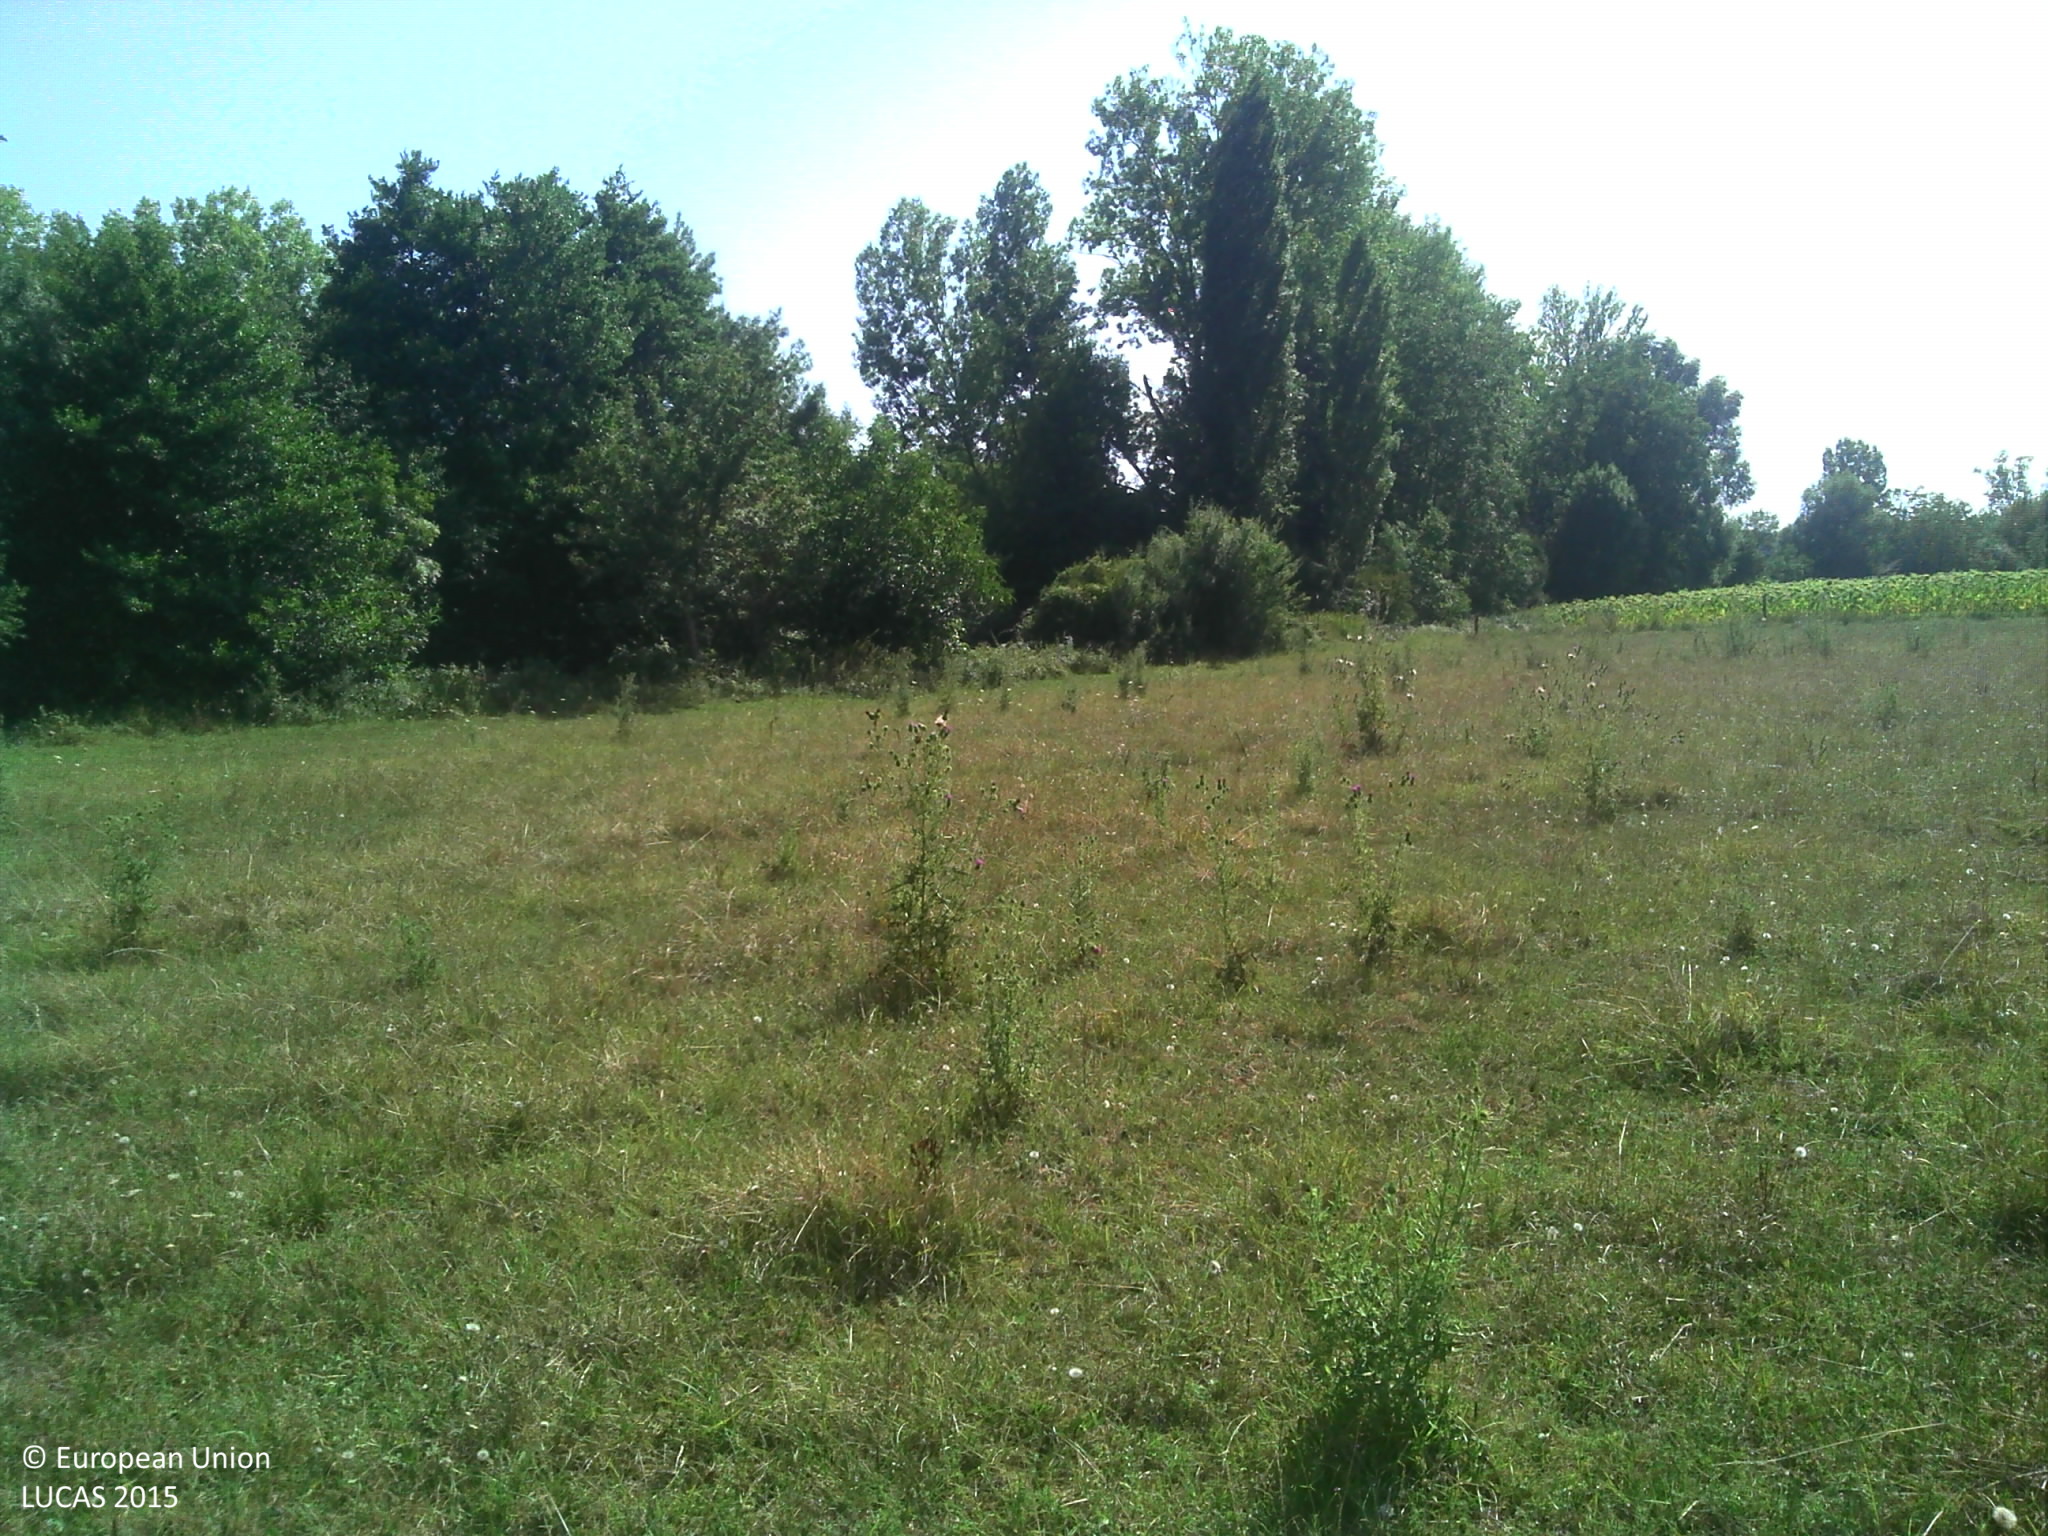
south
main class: Grassland
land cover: Grassland without tree/shrub cover
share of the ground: > 75 %
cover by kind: herbaceous plants 100 %
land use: Agriculture (excluding fallow land and kitchen gardens)
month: August
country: FR
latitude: 44.1666
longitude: 1.3073
